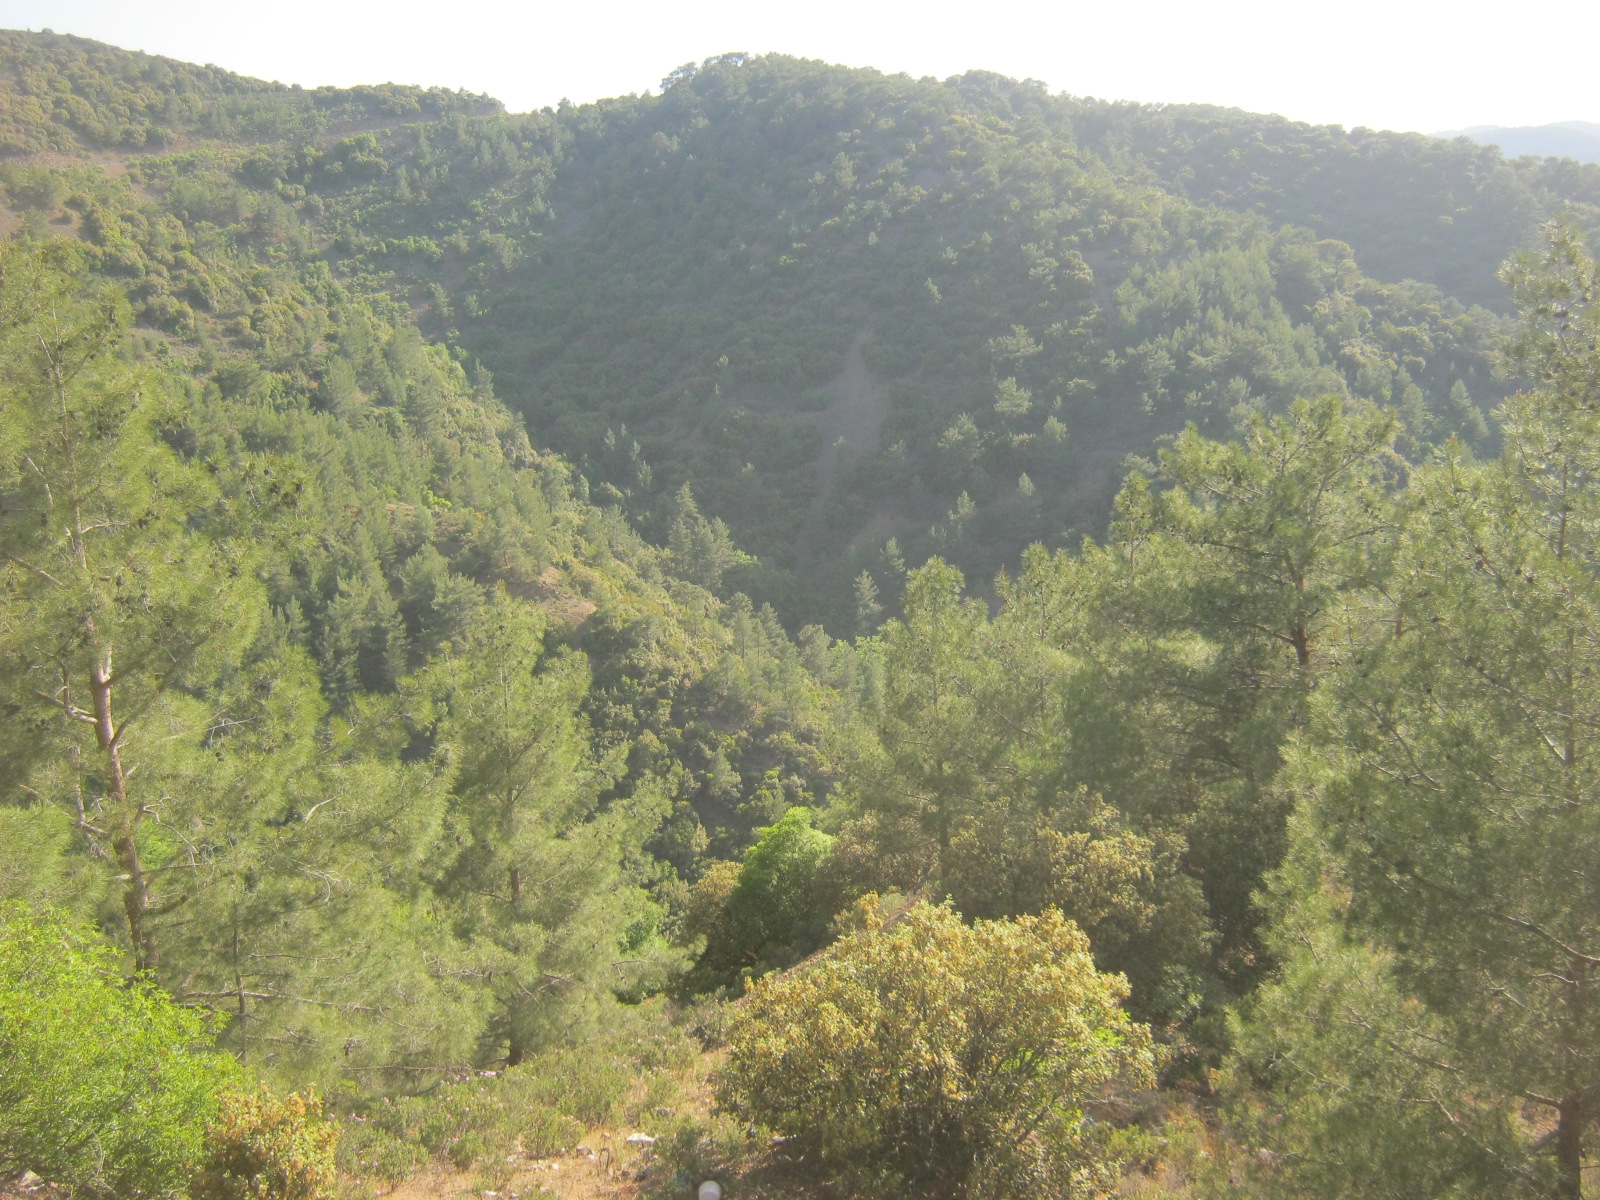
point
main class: Woodland
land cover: Pine dominated coniferous woodland
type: coniferous forest of the mediterranean region
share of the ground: > 75 %
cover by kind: coniferous forest trees 80 %, broadleaved forest trees 10 %, shrubs 10 %
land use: Semi-natural and natural areas not in use
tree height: > 5 m
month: May
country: CY
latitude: 34.9745
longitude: 32.8061
